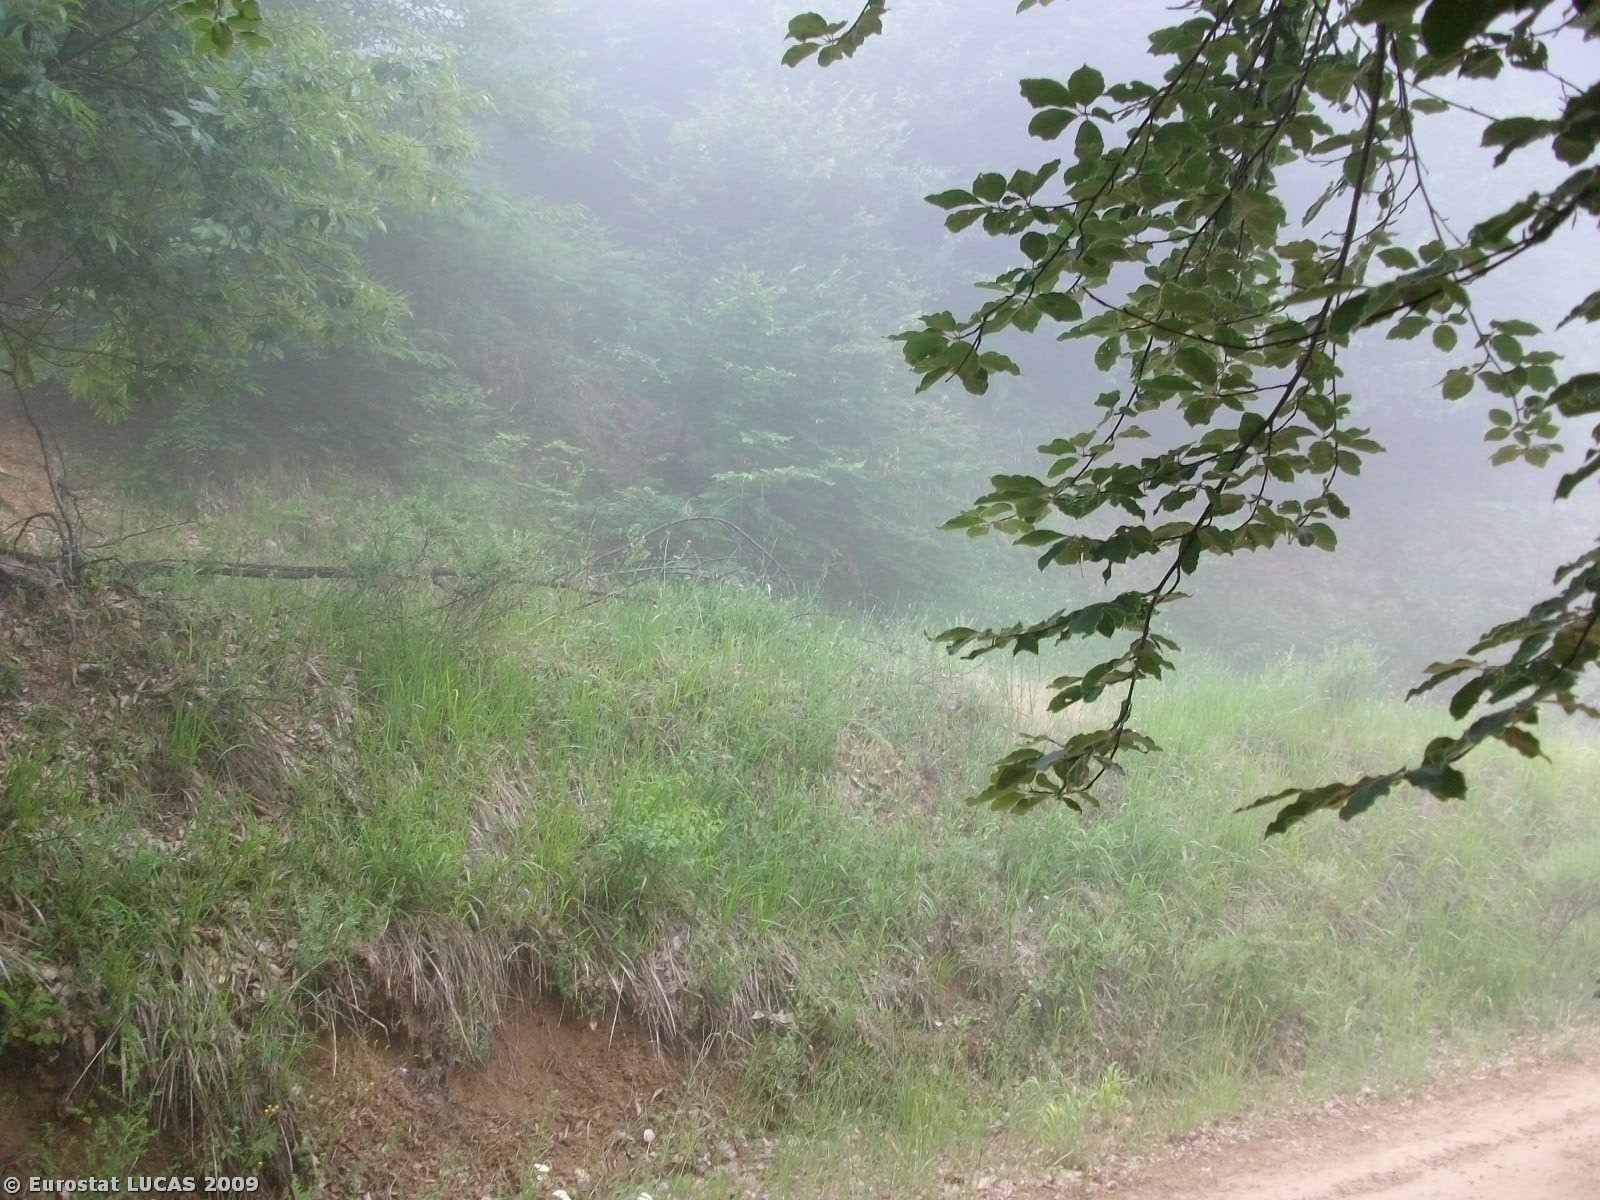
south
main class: Woodland
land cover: Broadleaved woodland
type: beech forest
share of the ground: > 75 %
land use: Forestry
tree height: > 5 m
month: May
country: GR
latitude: 39.8501
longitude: 22.6289
